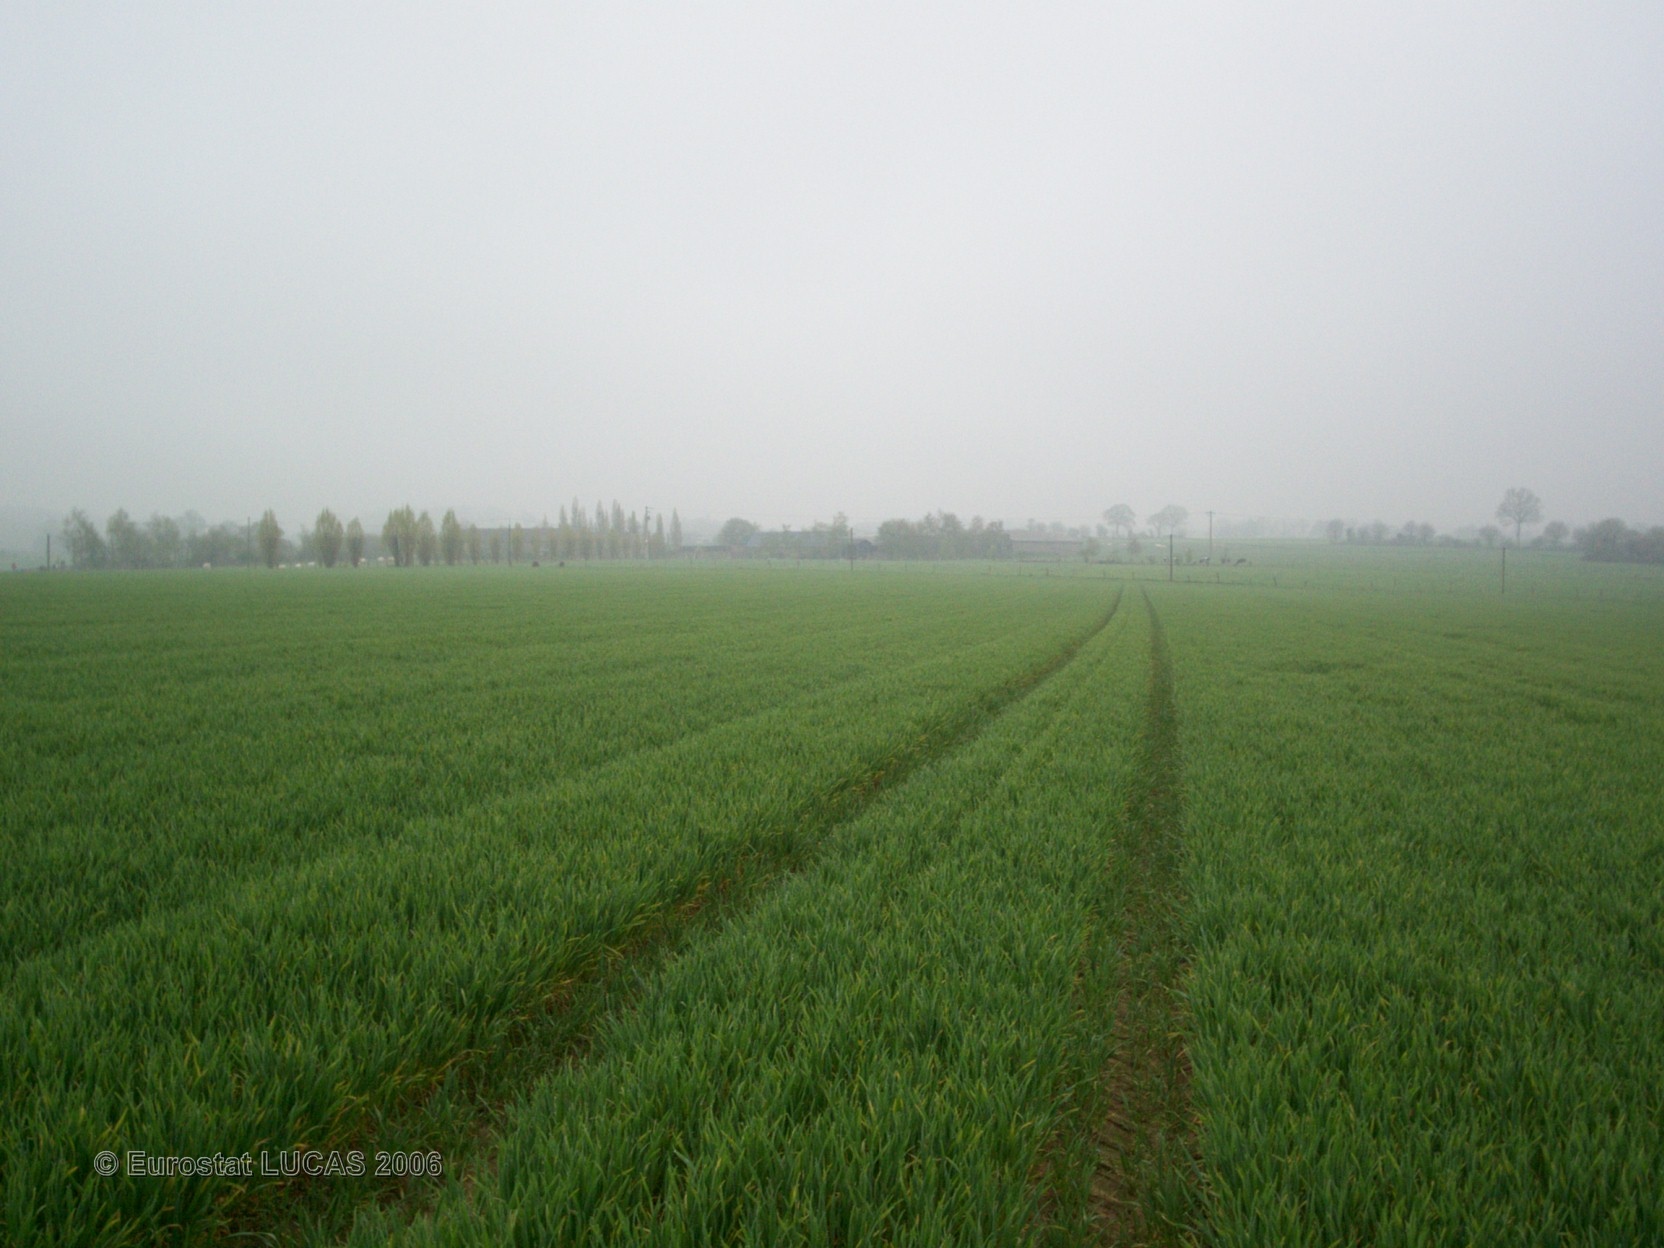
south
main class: Cropland
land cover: Common wheat
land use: Agriculture (excluding fallow land and kitchen gardens)
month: April
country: FR
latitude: 48.2316
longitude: -0.6579
